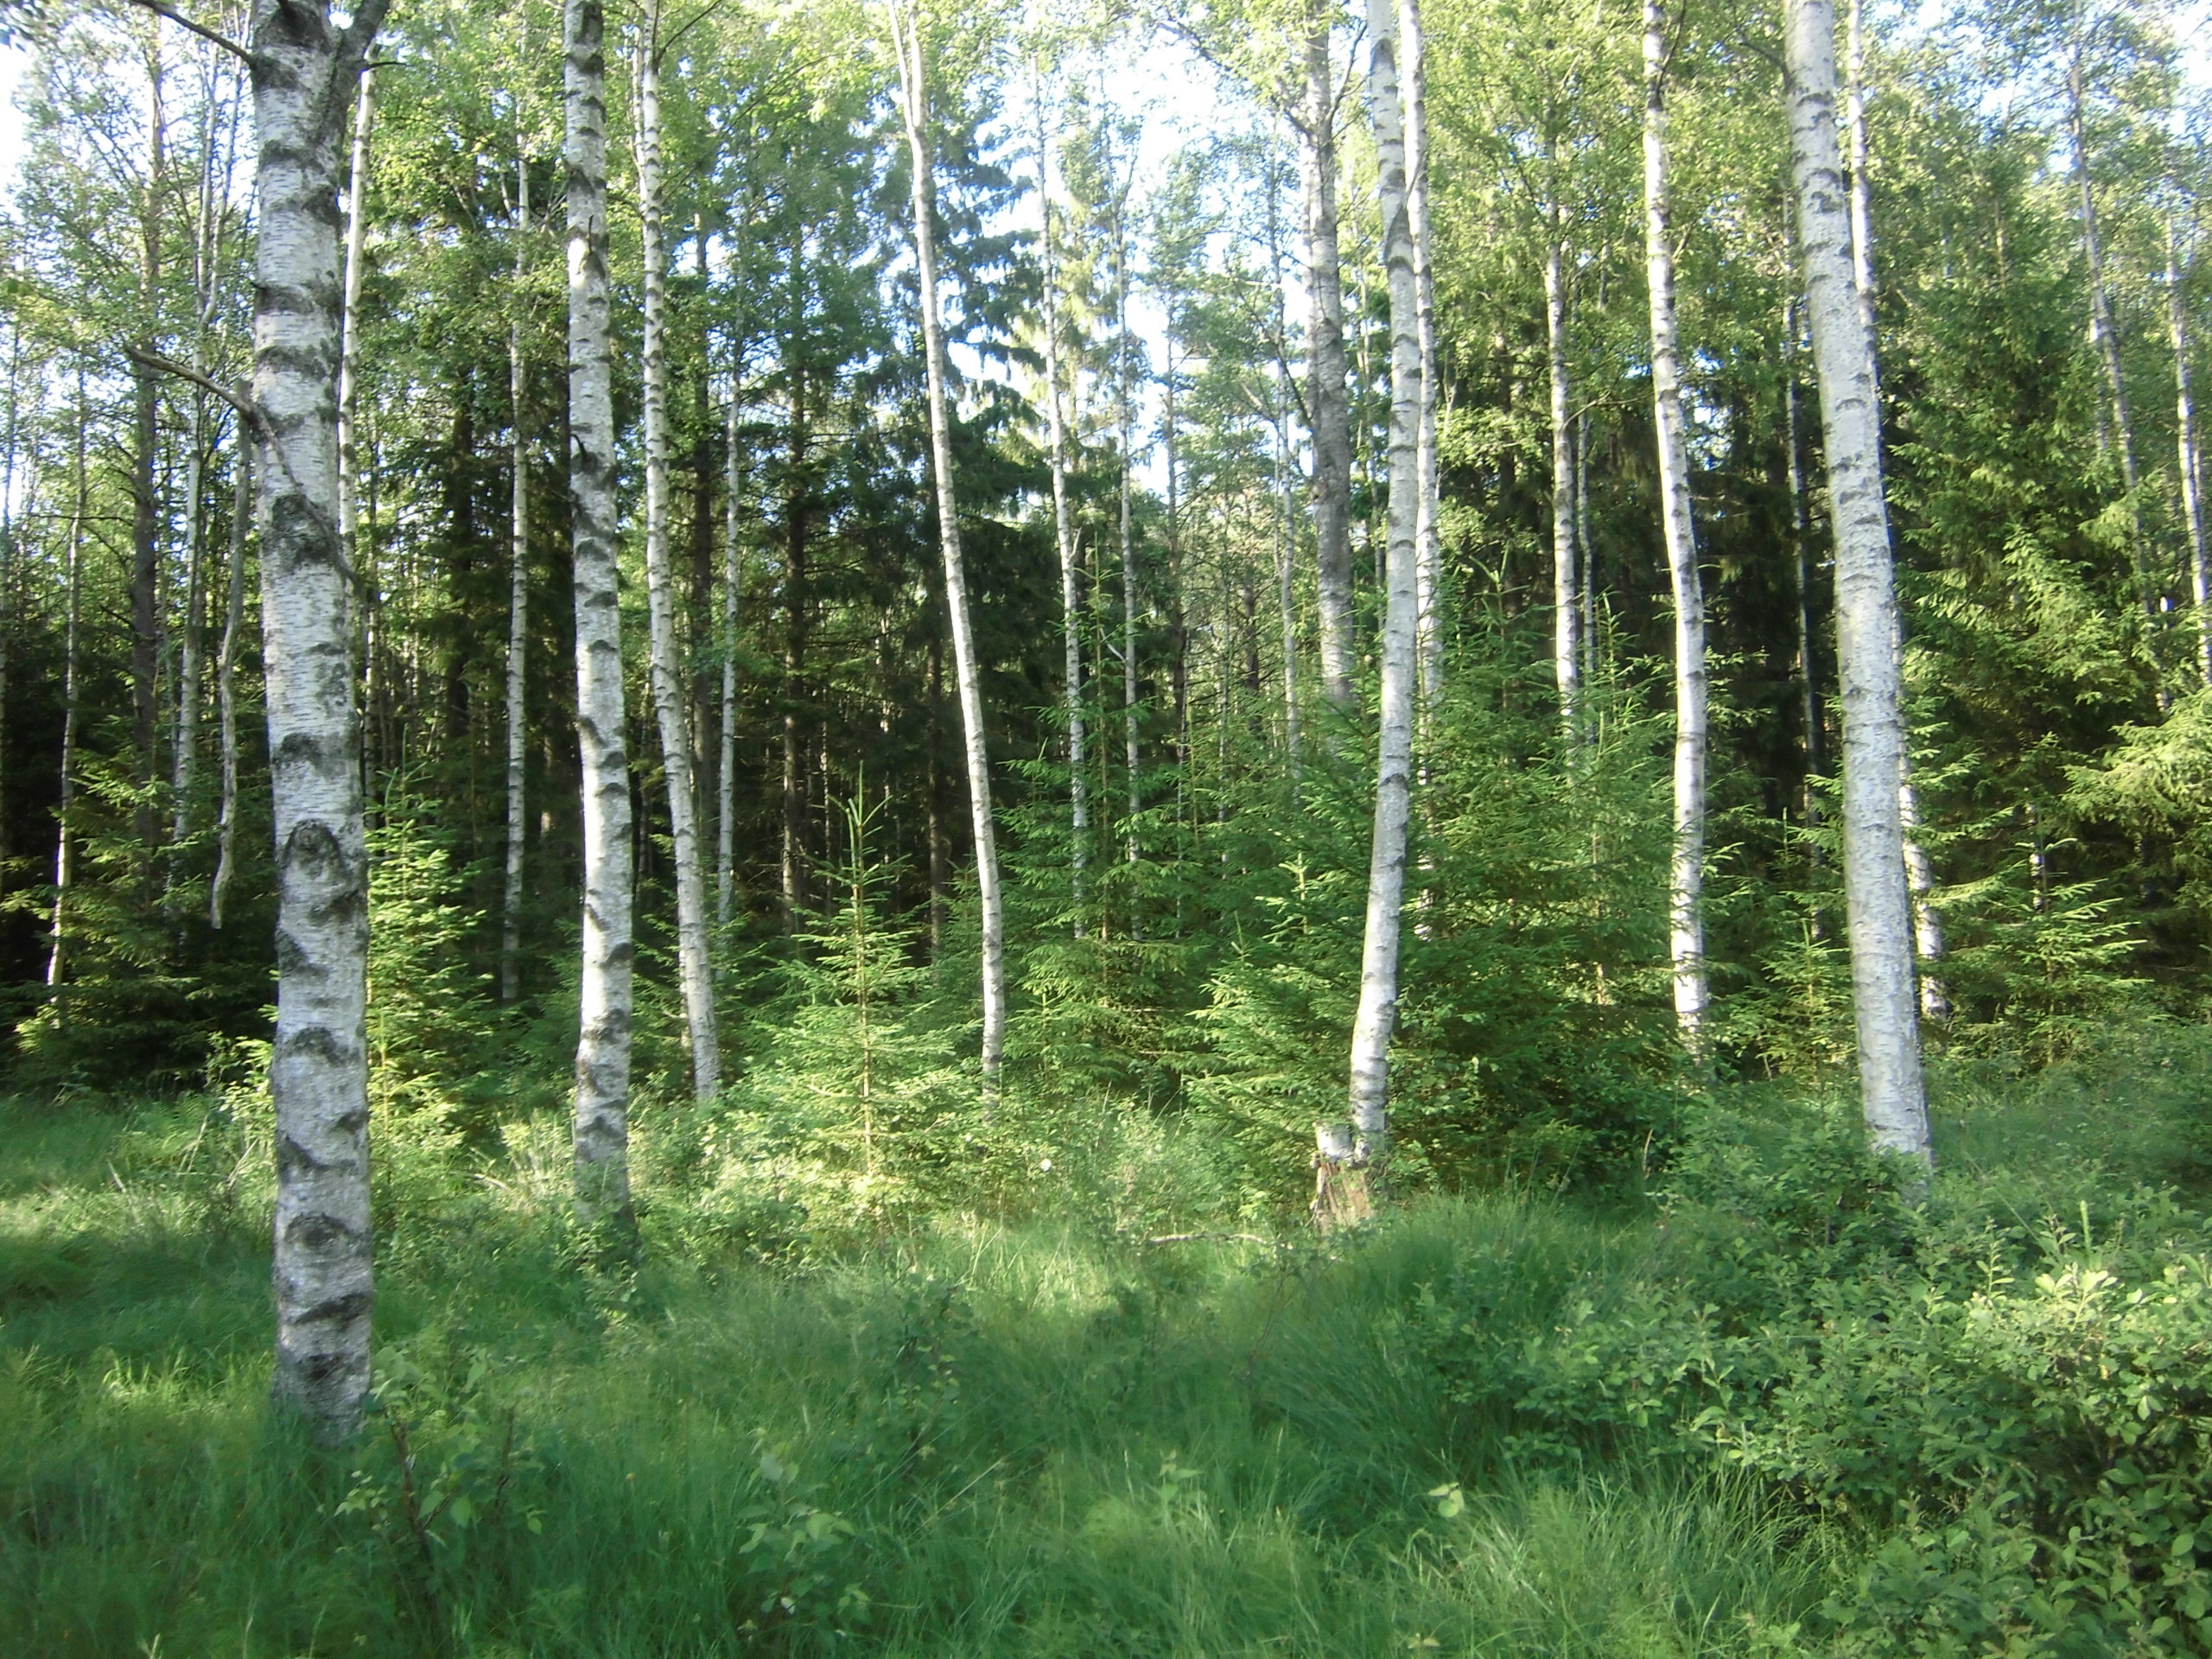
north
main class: Woodland
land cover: Spruce dominated mixed woodland
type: boreal forest
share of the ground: 50 - 75 %
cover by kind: broadleaved forest trees 35 %, herbaceous plants 30 %, coniferous forest trees 25 %, shrubs 5 %, lichens and mosses 5 %
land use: Forestry
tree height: > 5 m
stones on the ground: < 10 %
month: July
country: SE
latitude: 57.1966
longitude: 15.2766
